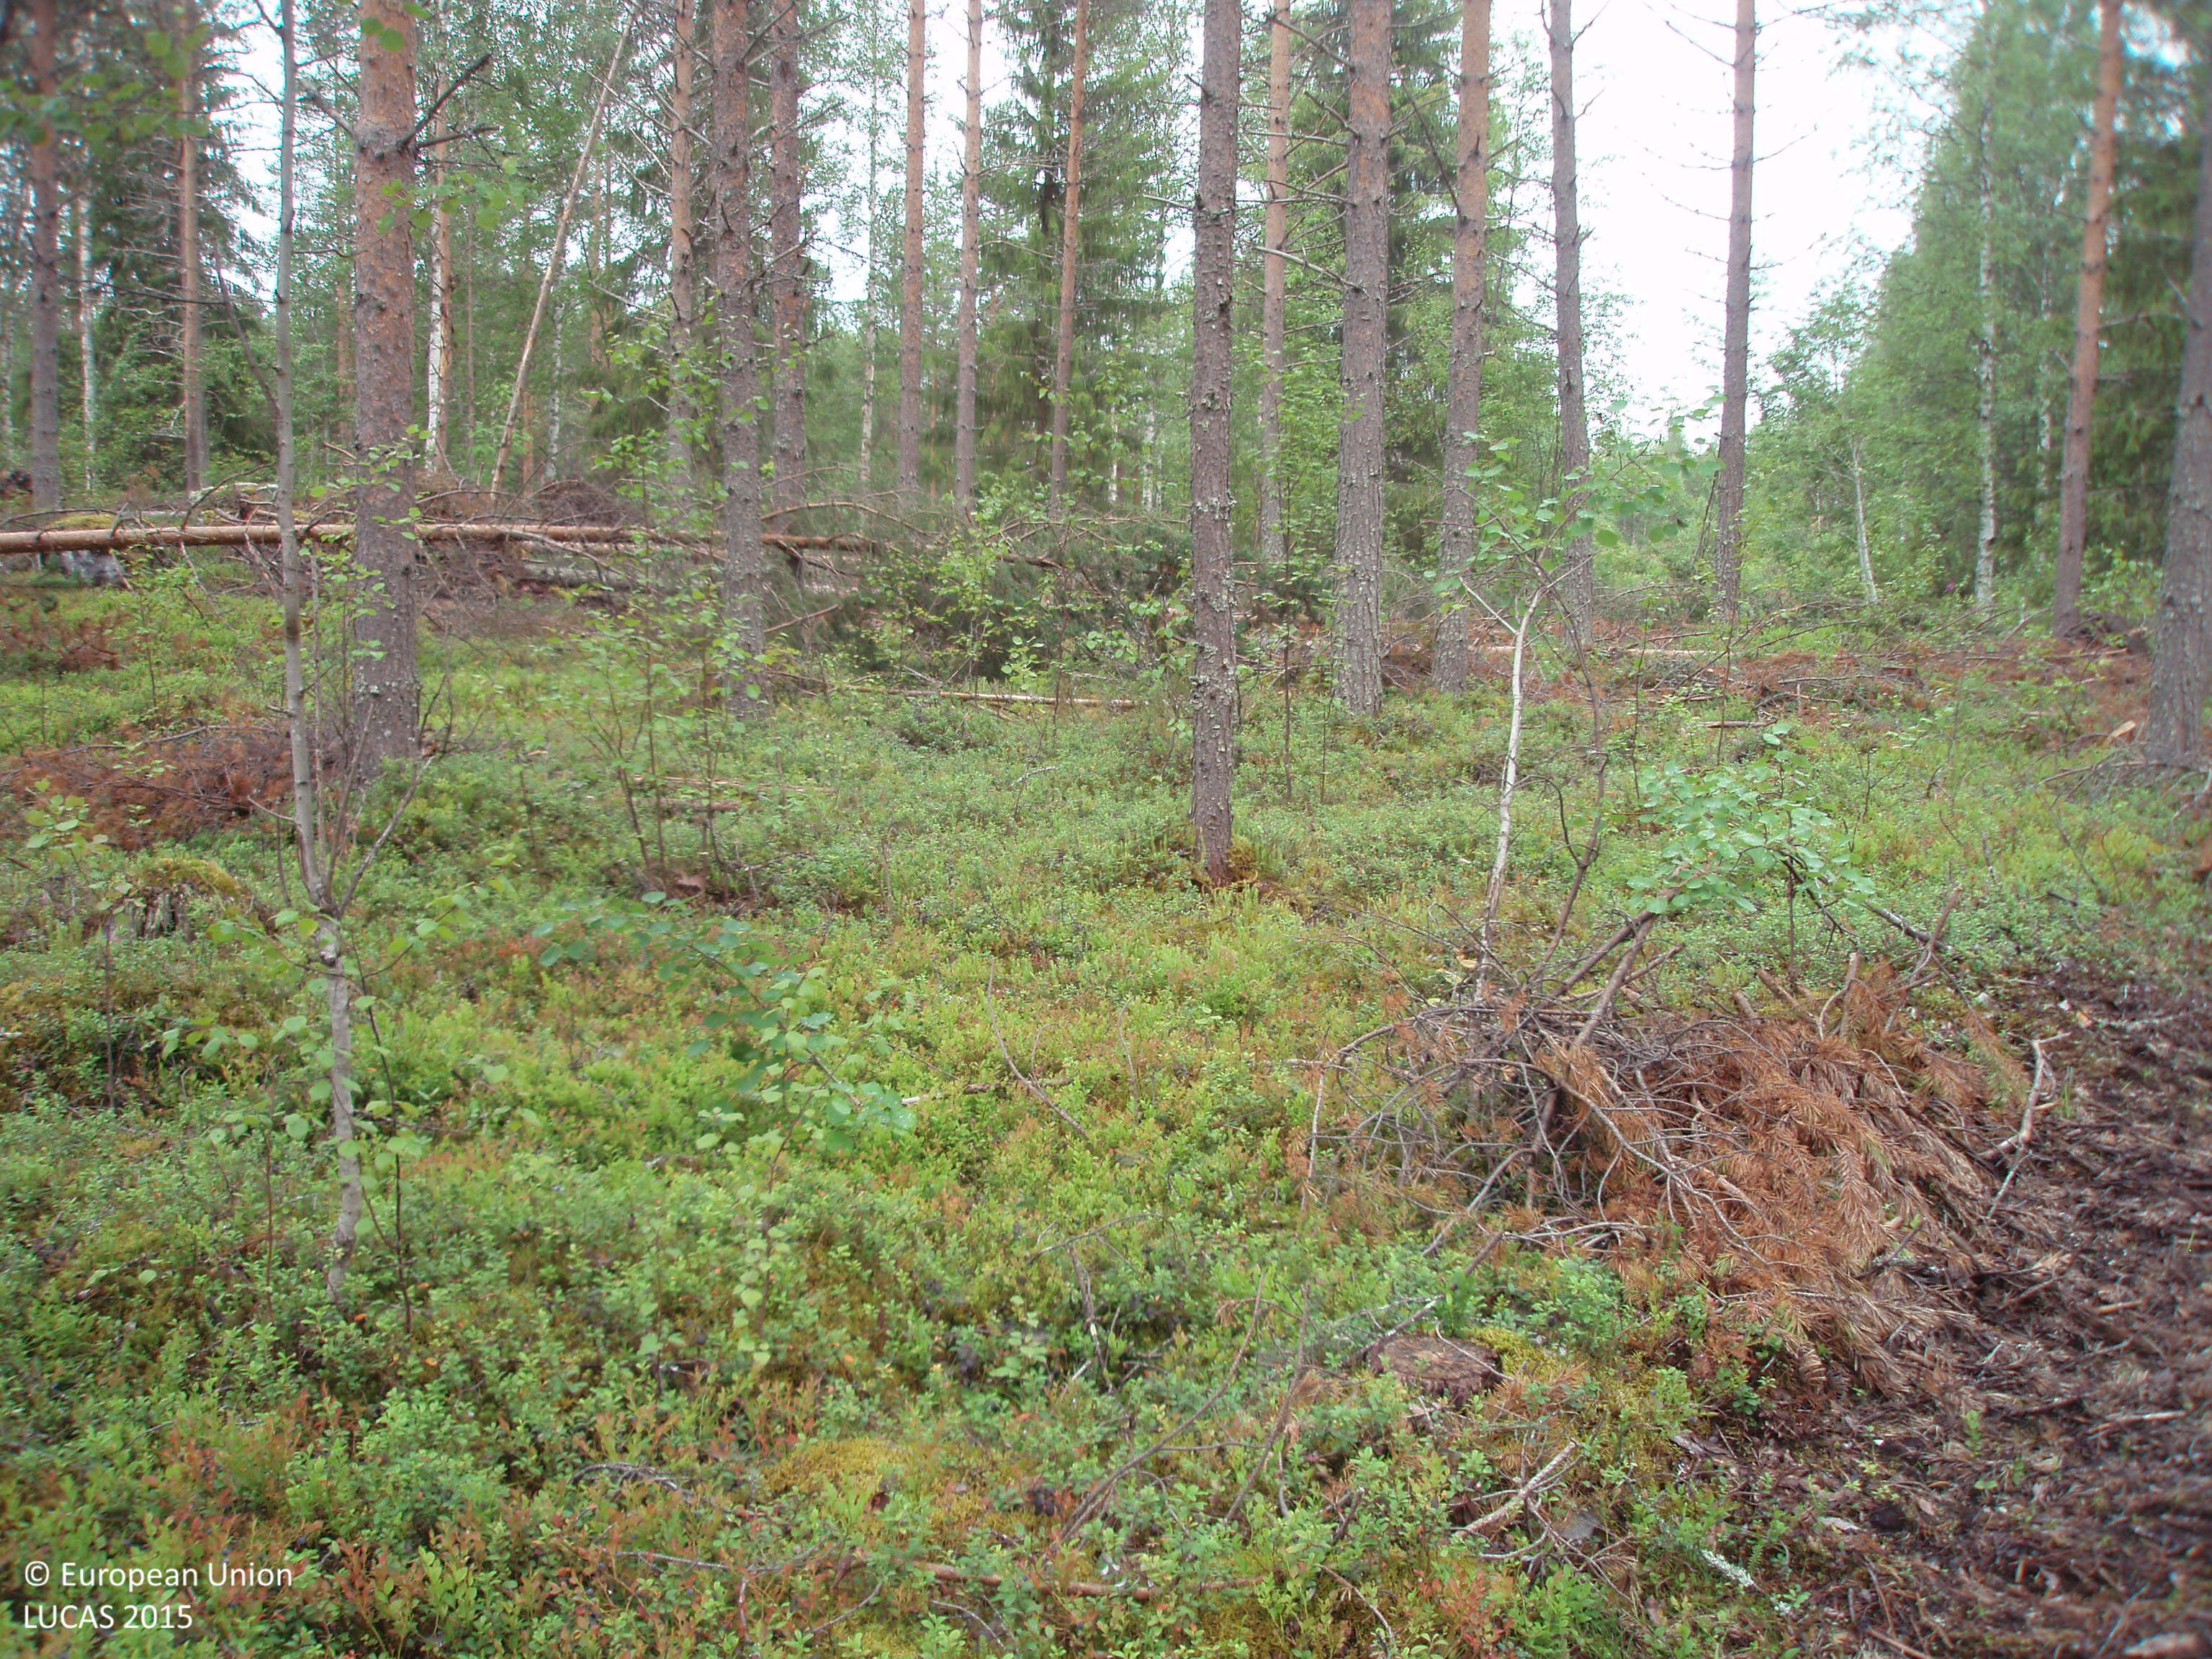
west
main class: Woodland
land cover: Pine dominated coniferous woodland
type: boreal forest
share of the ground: 50 - 75 %
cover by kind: coniferous forest trees 60 %, shrubs 40 %
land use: Forestry
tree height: > 5 m
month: August
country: FI
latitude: 65.5451
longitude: 27.2451
